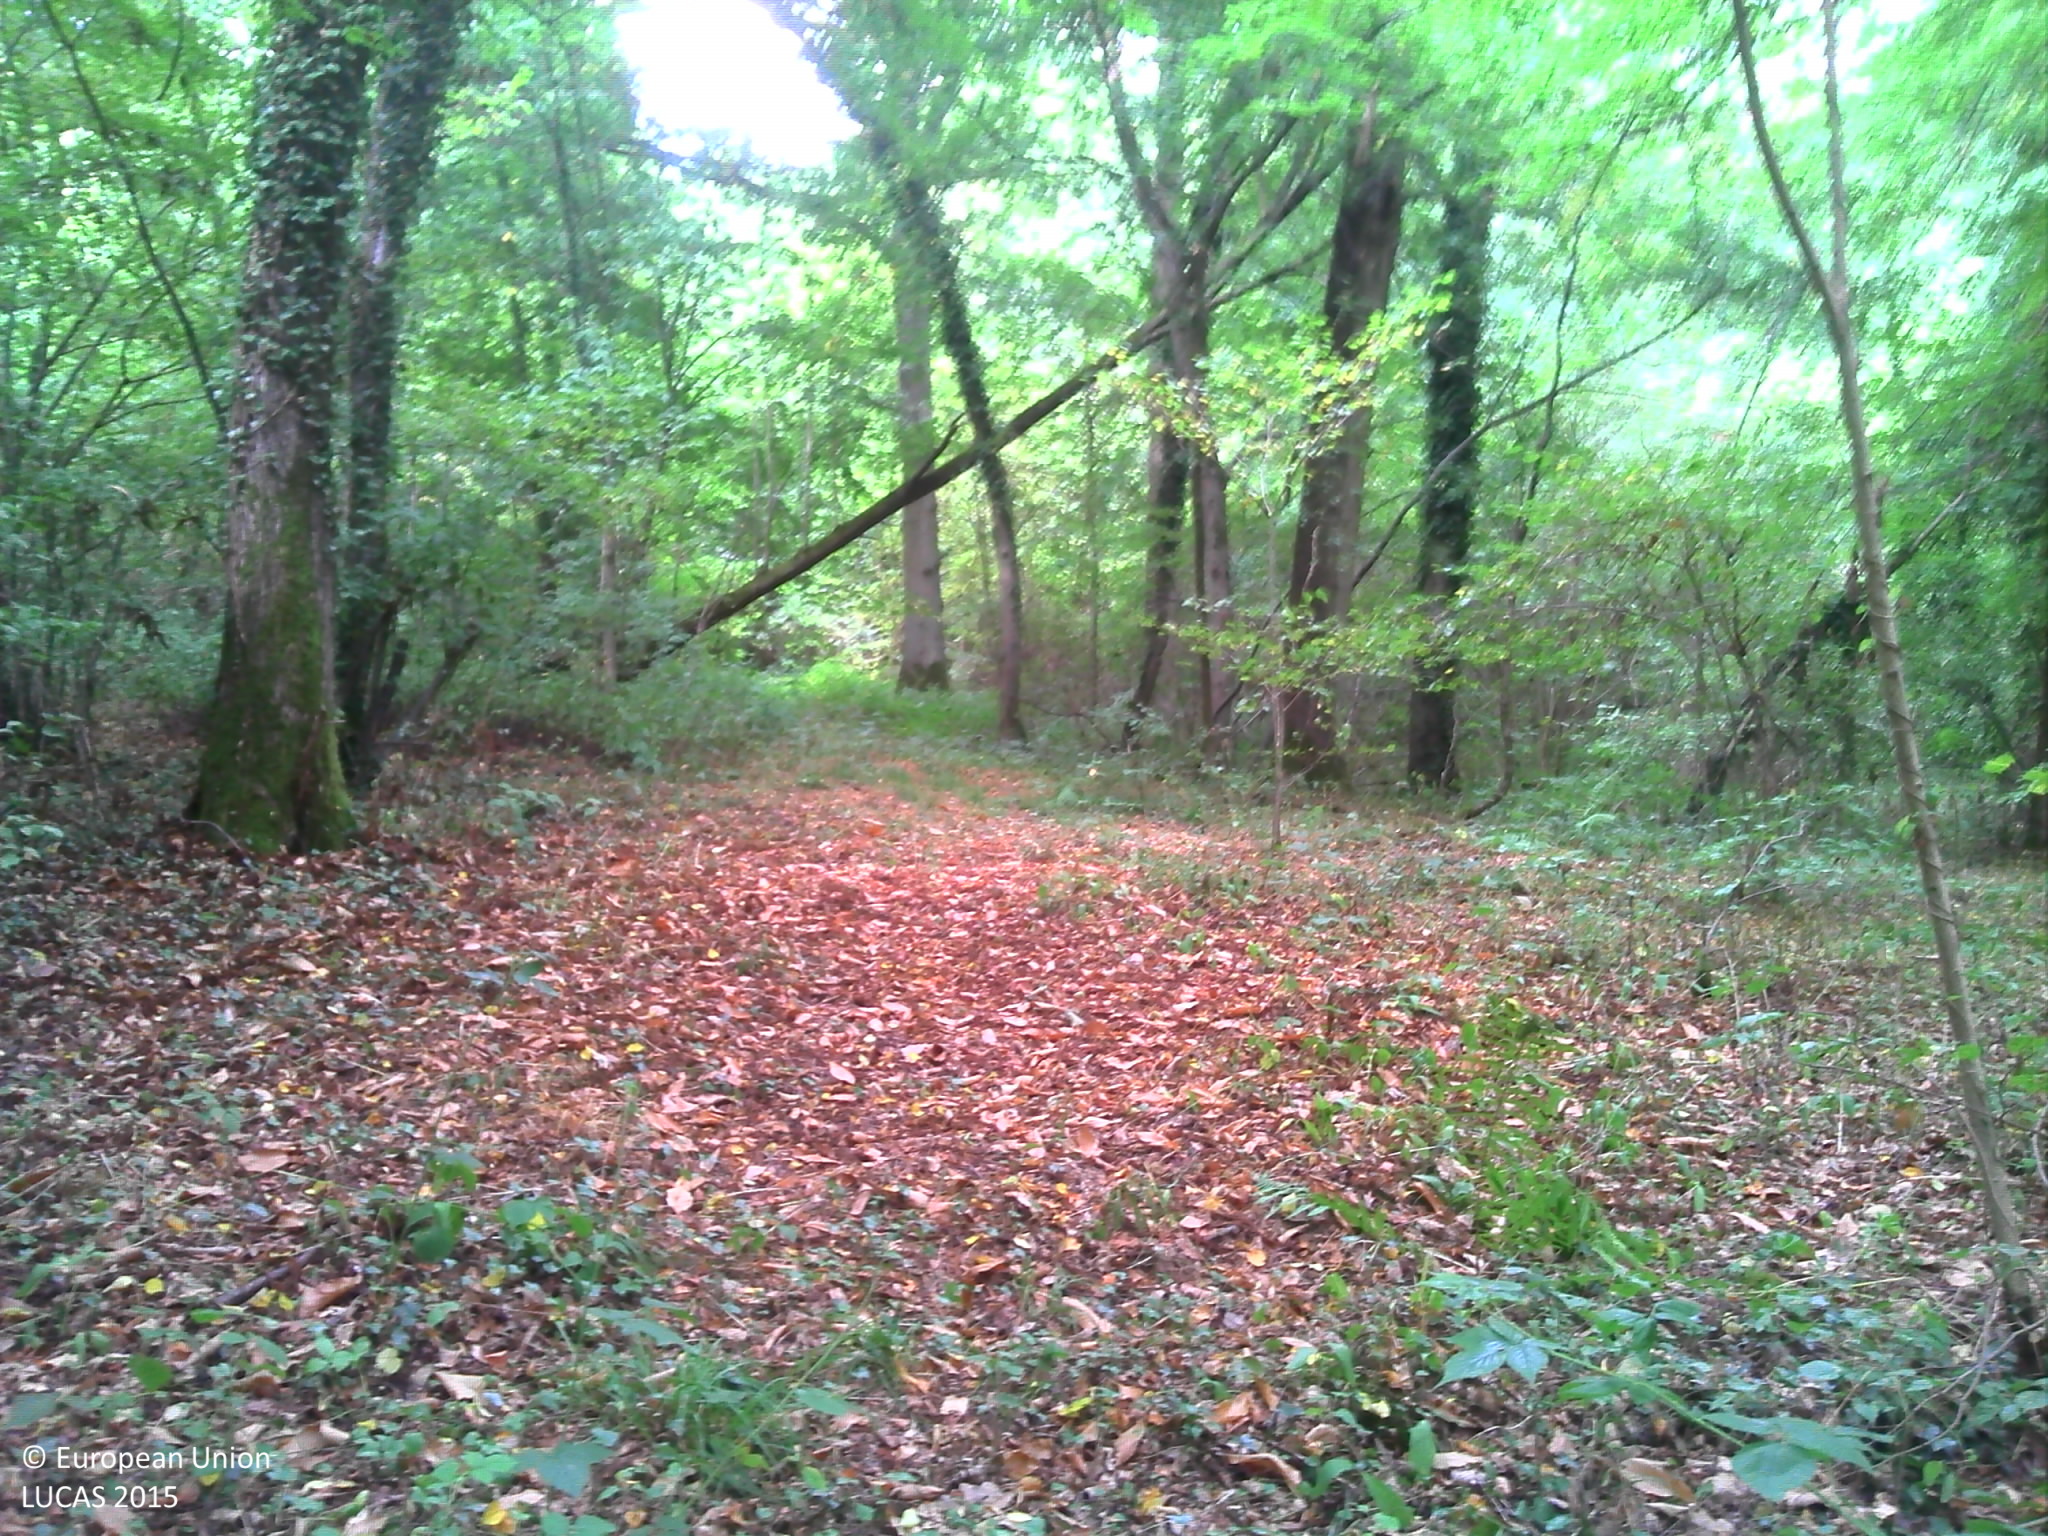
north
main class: Woodland
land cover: Broadleaved woodland
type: hemiboreal forest and nemoral coniferous forest and mixed broadleaved-coniferous forest
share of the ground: > 75 %
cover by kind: broadleaved forest trees 60 %, herbaceous plants 20 %, lichens and mosses 10 %, unconsolidated bare surface 10 %
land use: Forestry
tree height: > 5 m
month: August
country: FR
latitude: 48.9021
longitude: 2.6912
